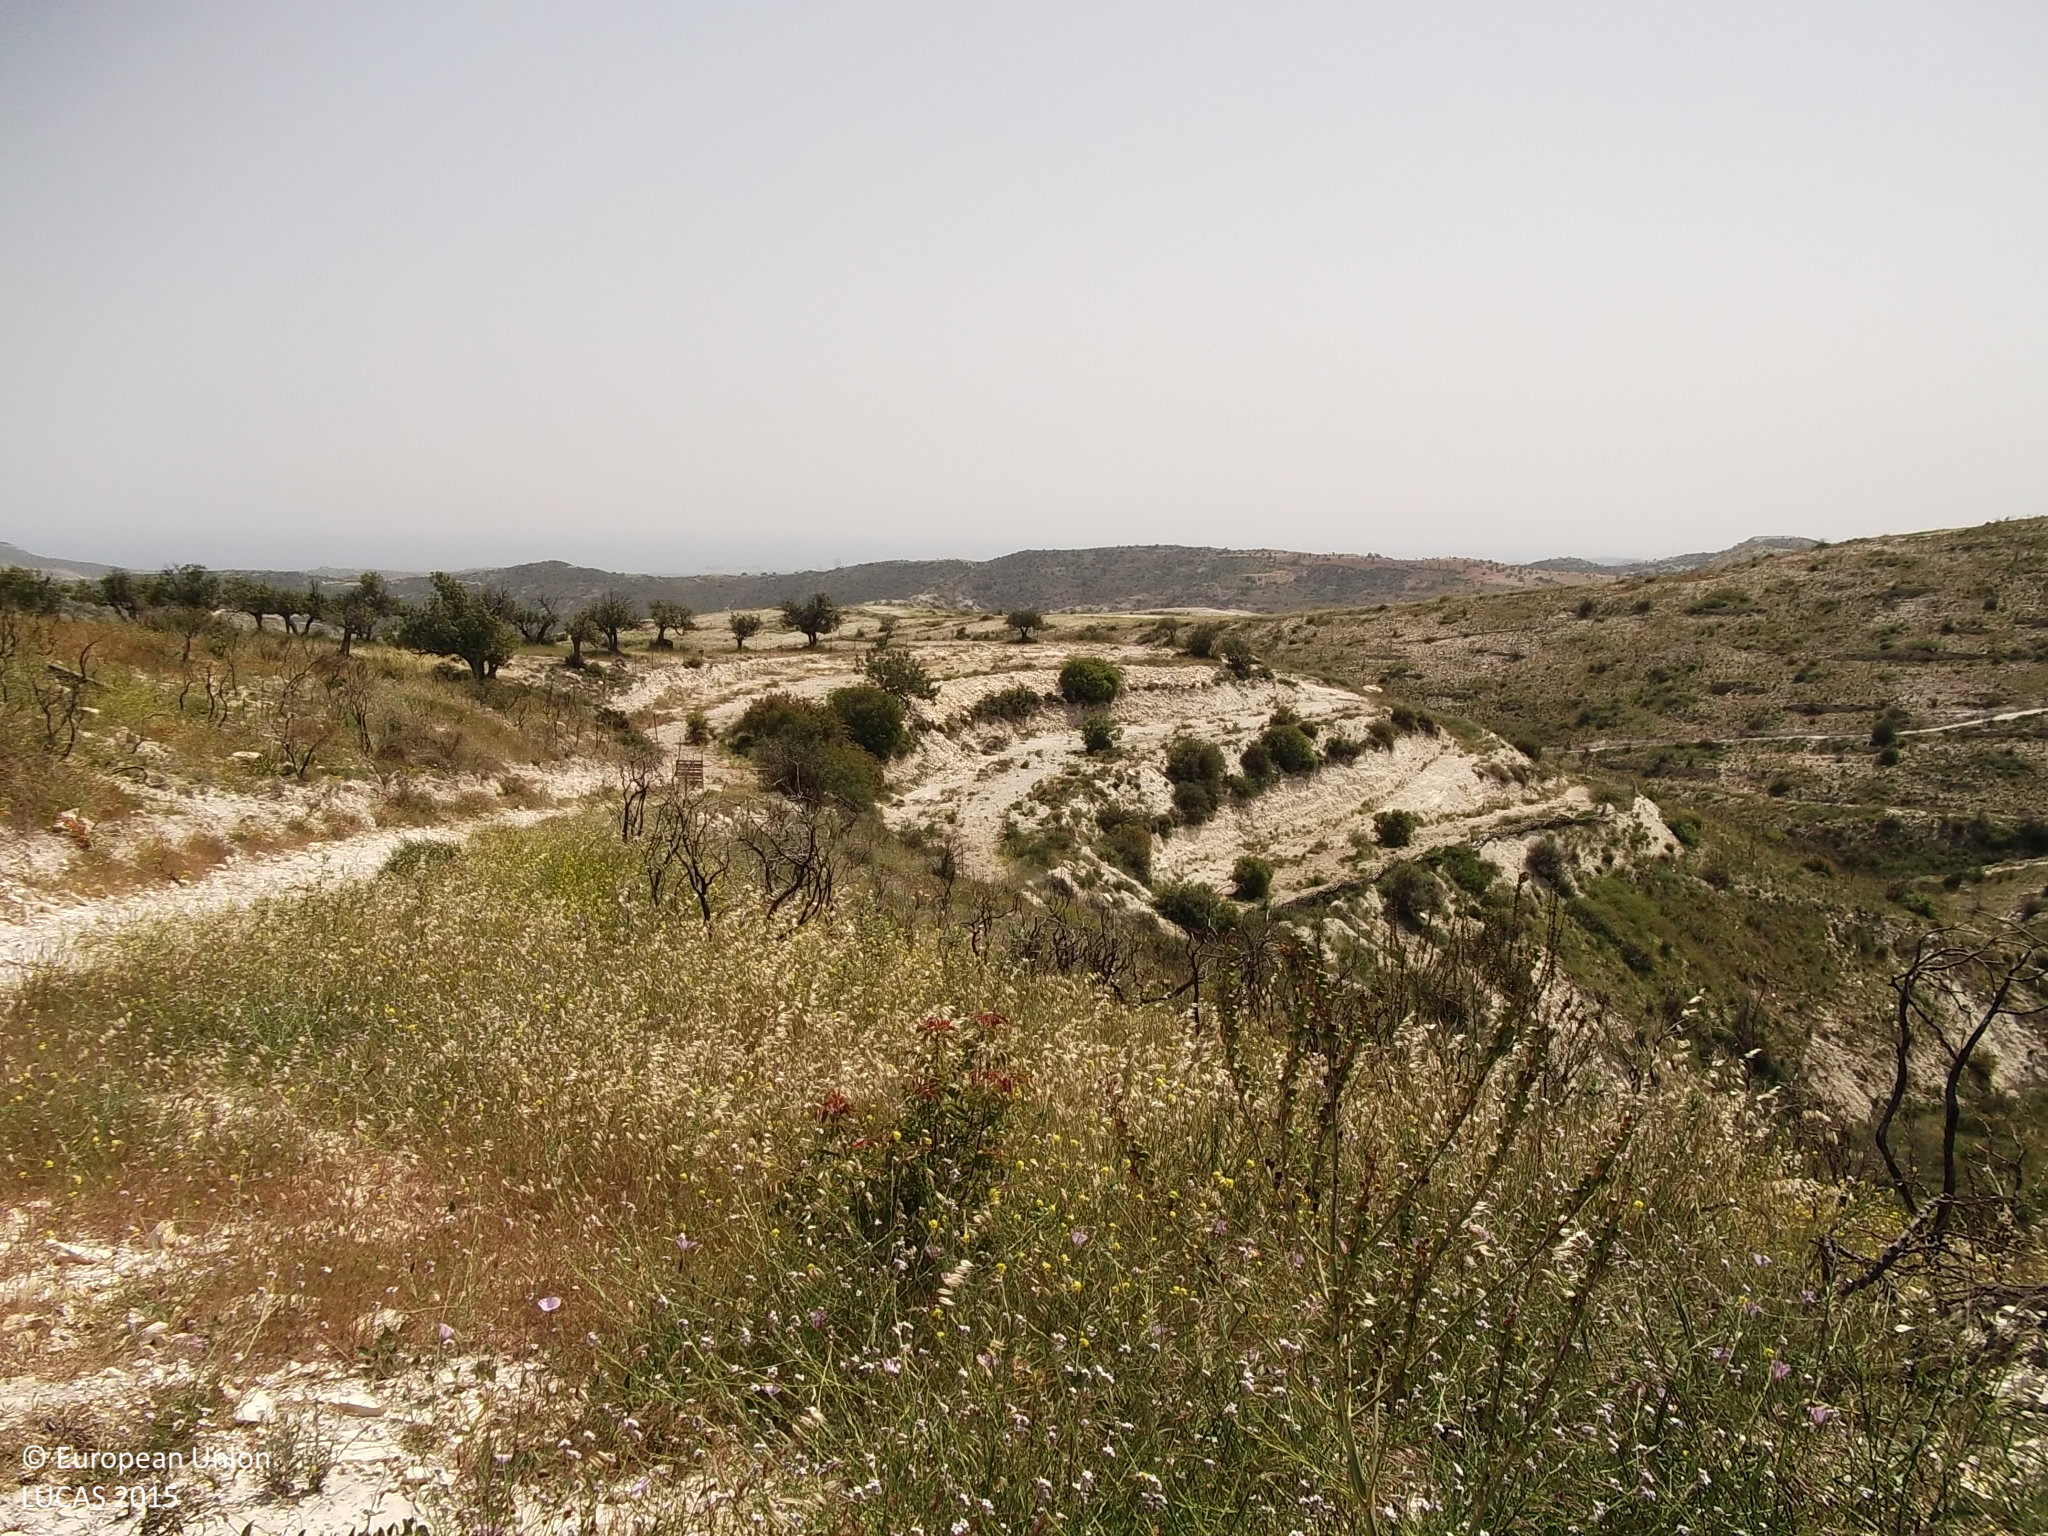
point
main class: Grassland
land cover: Spontaneously vegetated surfaces
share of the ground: 50 - 75 %
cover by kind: herbaceous plants 60 %, unconsolidated bare surface 40 %
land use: Semi-natural and natural areas not in use
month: April
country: CY
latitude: 34.8398
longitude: 33.3320
